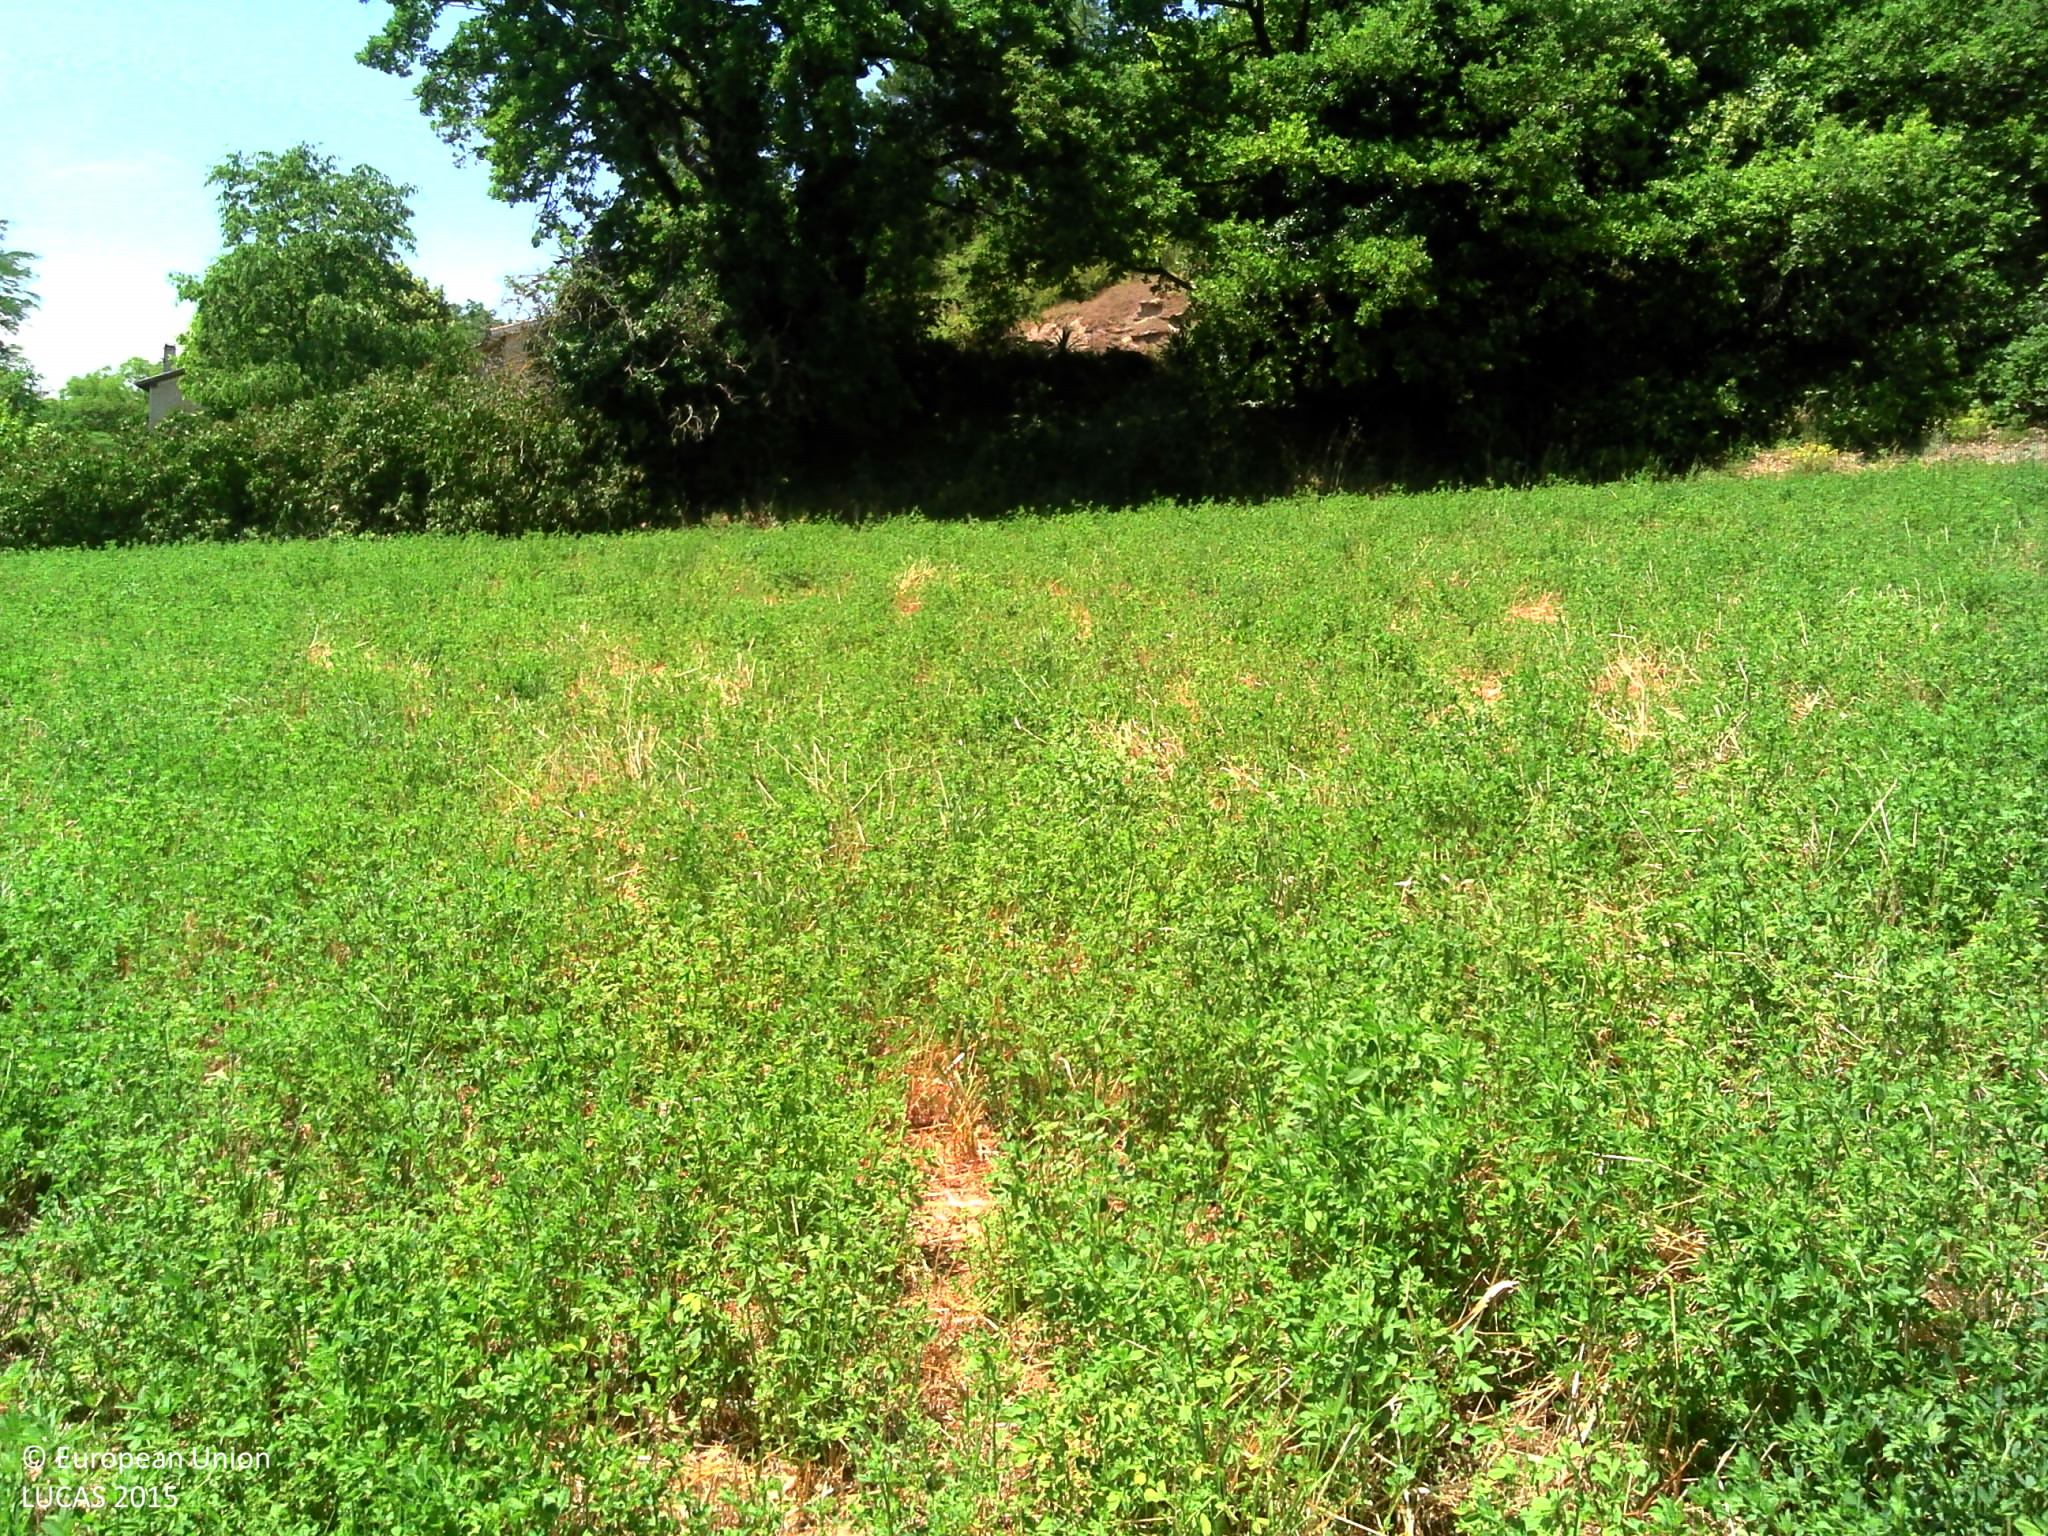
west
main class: Cropland
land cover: Lucerne
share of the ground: > 75 %
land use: Agriculture (excluding fallow land and kitchen gardens)
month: May
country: FR
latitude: 45.0617
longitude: 5.0146
